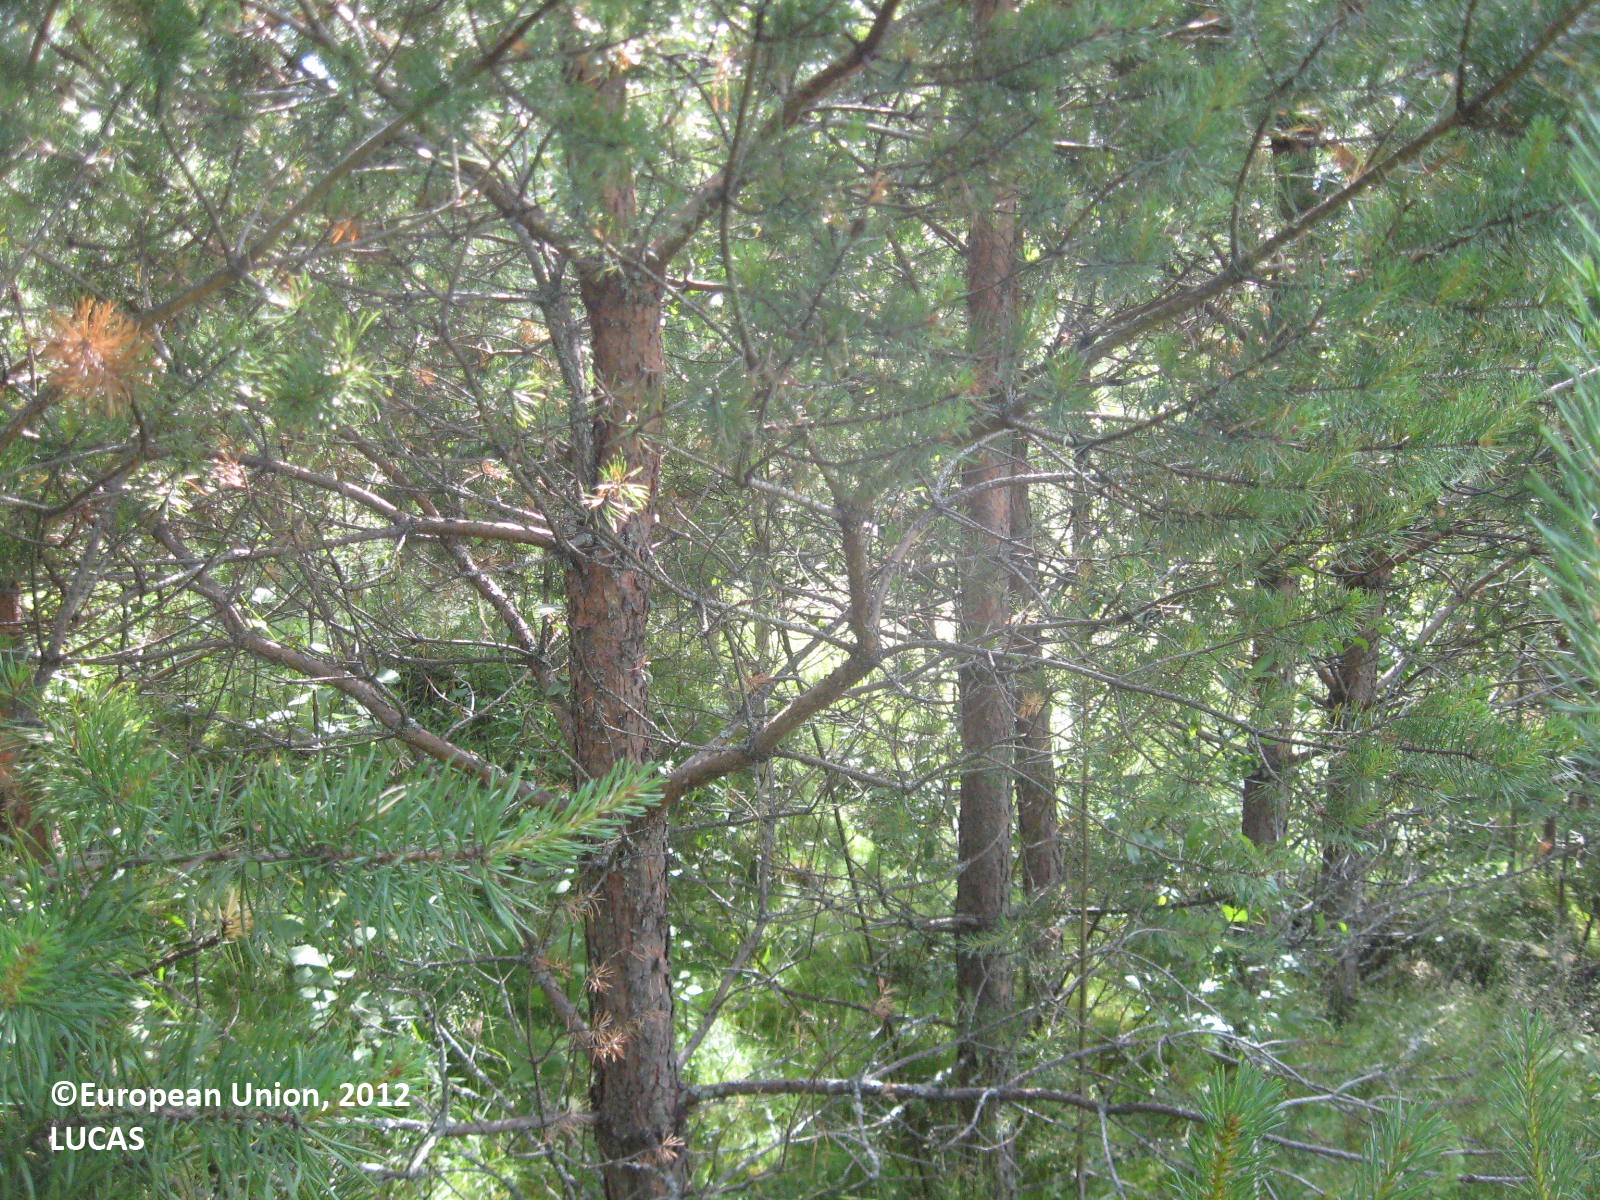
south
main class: Woodland
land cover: Other mixed woodland
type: boreal forest
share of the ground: > 75 %
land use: Forestry
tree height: > 5 m
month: July
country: FI
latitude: 62.2506
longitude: 22.3188
